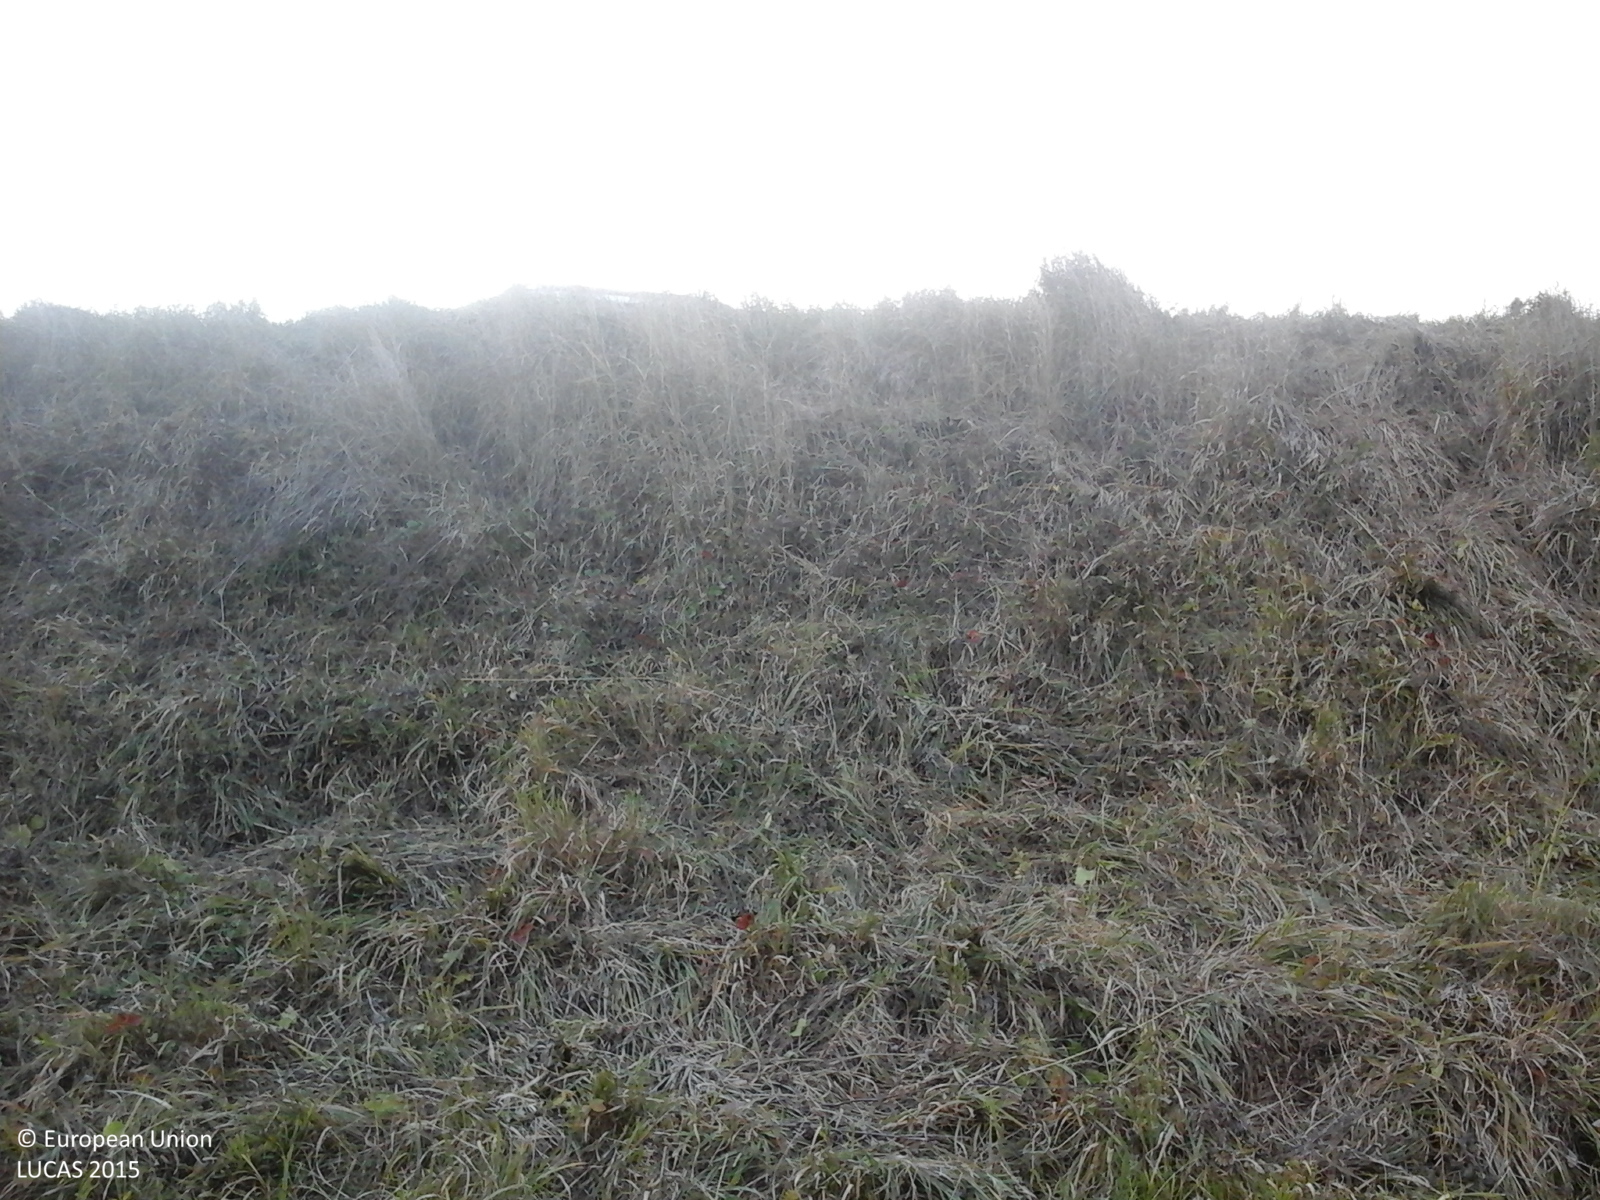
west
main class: Grassland
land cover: Spontaneously vegetated surfaces
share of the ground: > 75 %
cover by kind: herbaceous plants 100 %
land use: Fallow land
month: October
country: RO
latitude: 46.3927
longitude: 25.9456
